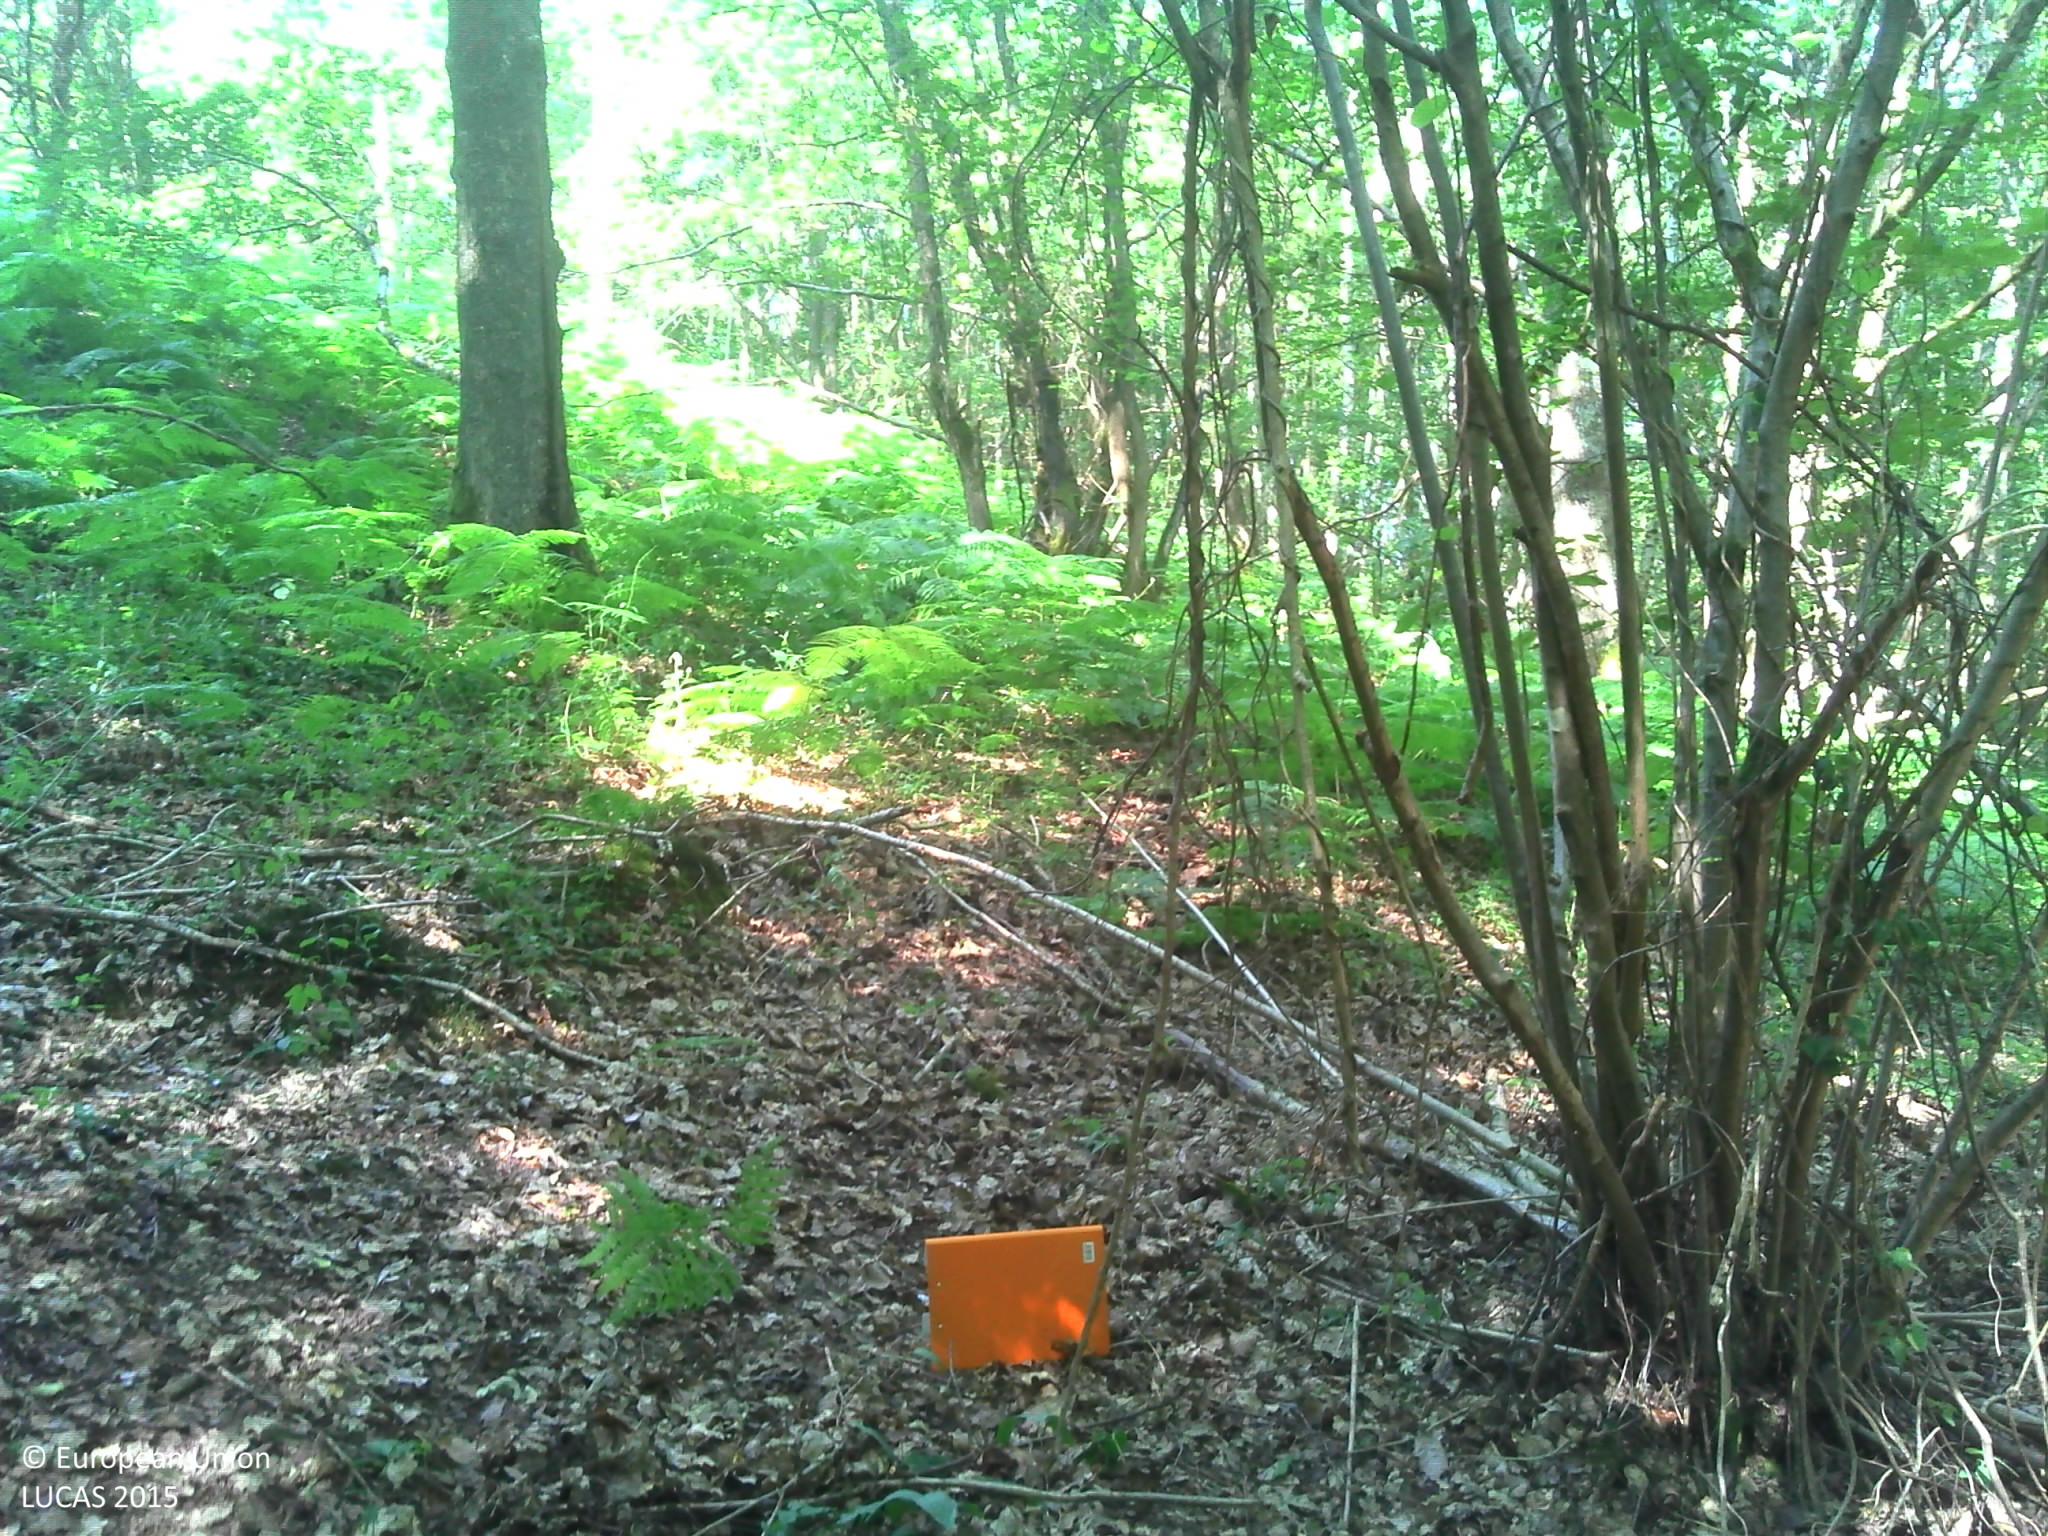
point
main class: Woodland
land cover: Broadleaved woodland
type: mesophytic deciduous forest
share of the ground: > 75 %
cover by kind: broadleaved forest trees 90 %, herbaceous plants 5 %, unconsolidated bare surface 5 %
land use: Forestry
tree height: > 5 m
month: July
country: FR
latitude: 49.0667
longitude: 3.2994
